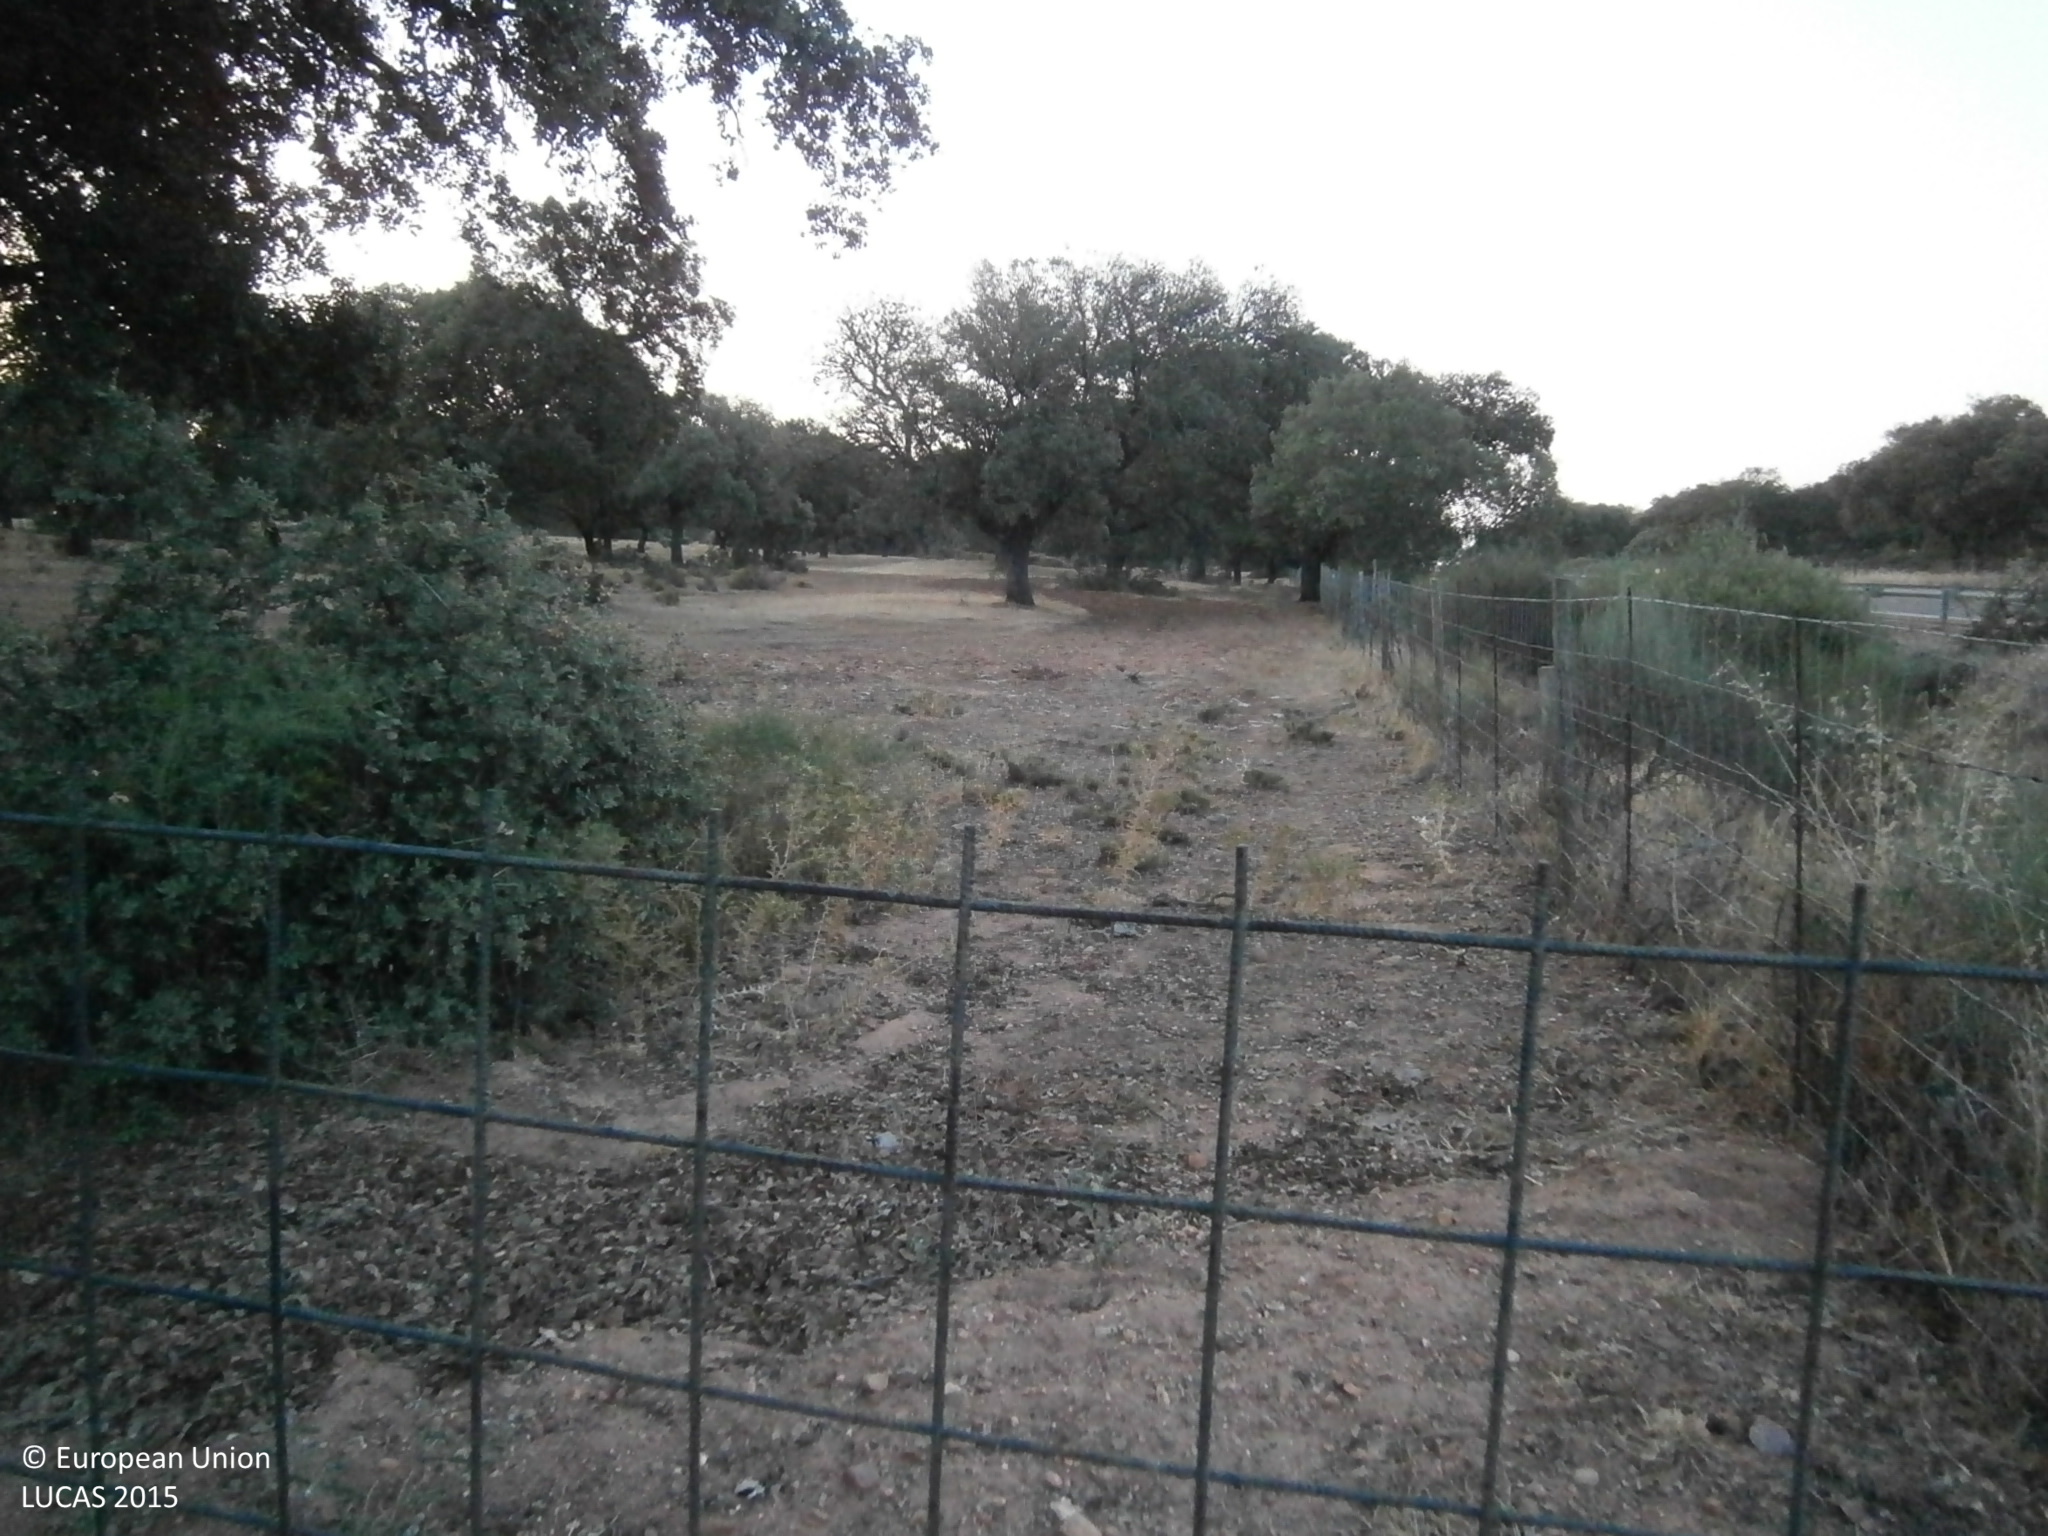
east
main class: Woodland
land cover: Broadleaved woodland
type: broadleaved evergreen forest
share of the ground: > 75 %
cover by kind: broadleaved forest trees 90 %, shrubs 5 %, unconsolidated bare surface 5 %
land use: Forestry
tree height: > 5 m
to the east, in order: Broadleaved woodland; Grassland with sparse tree/shrub cover
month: July
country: ES
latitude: 38.8348
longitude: -6.8510
